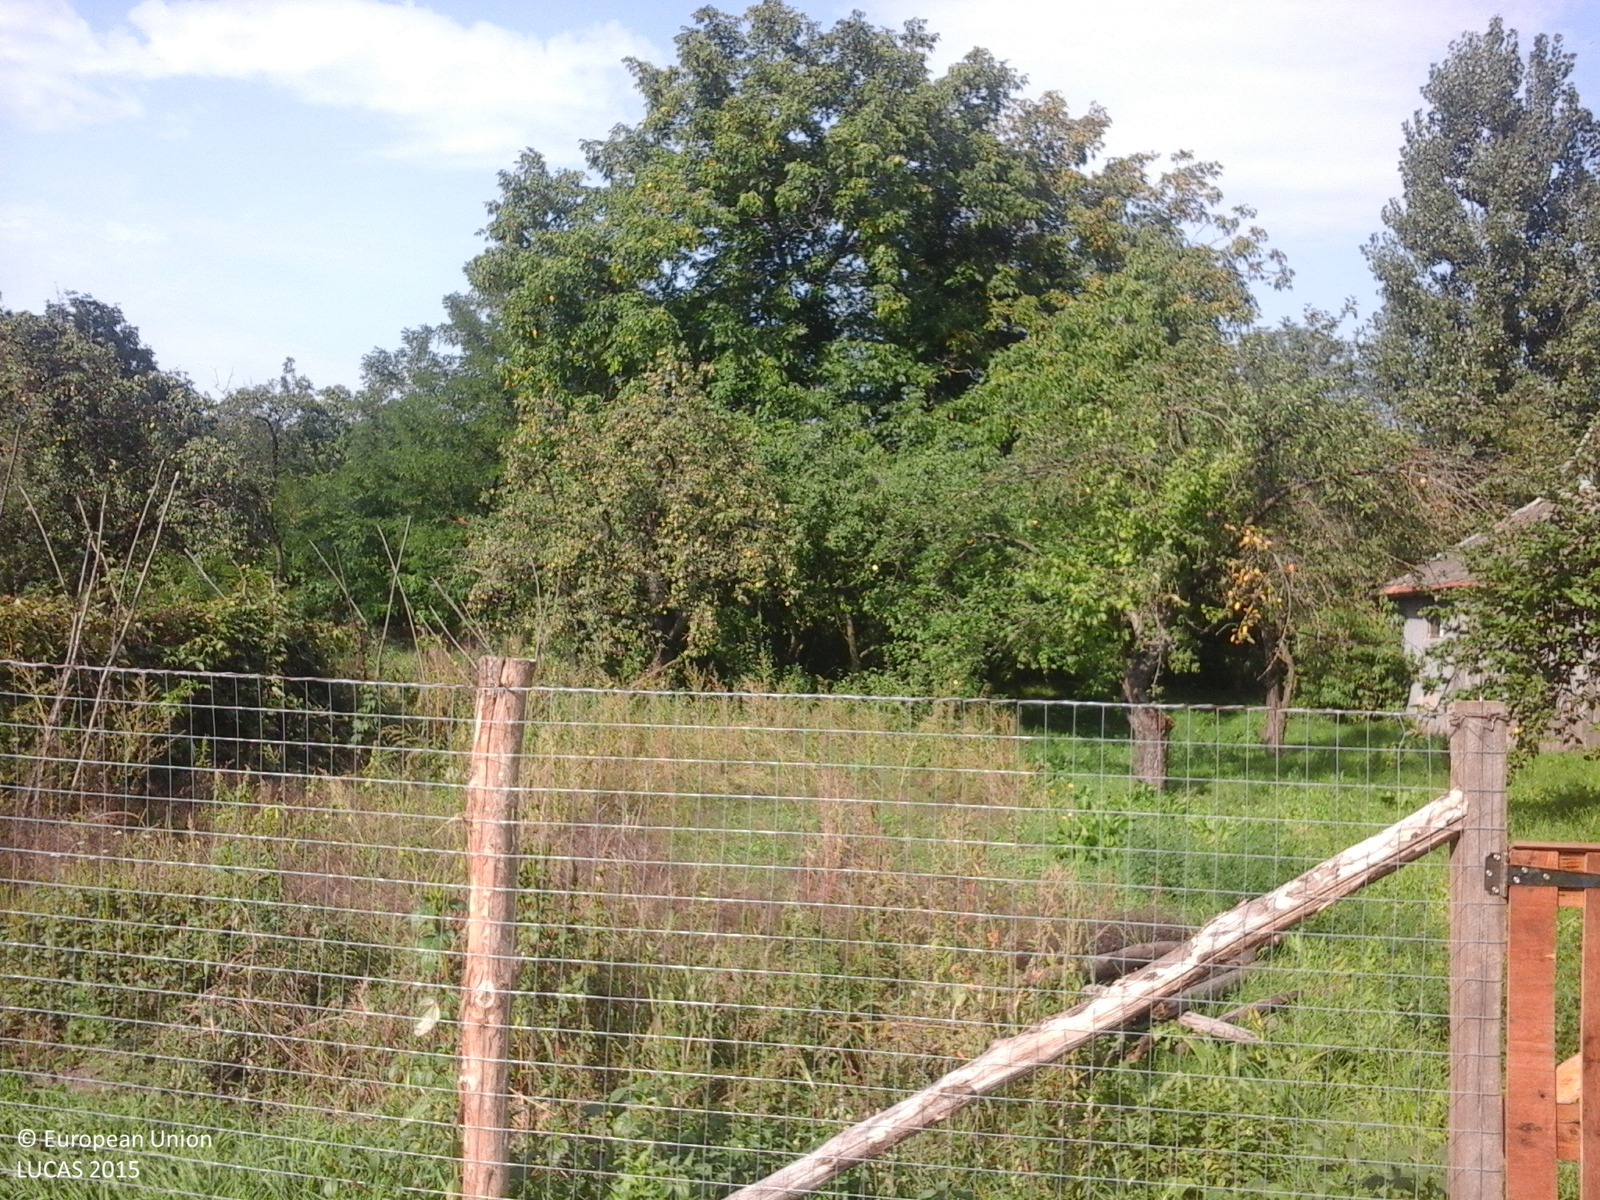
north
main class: Cropland
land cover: Apple fruit
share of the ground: > 75 %
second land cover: Grassland without tree/shrub cover
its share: > 75 %
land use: Agriculture (excluding fallow land and kitchen gardens)
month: September
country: RO
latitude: 46.7983
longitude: 23.2591
